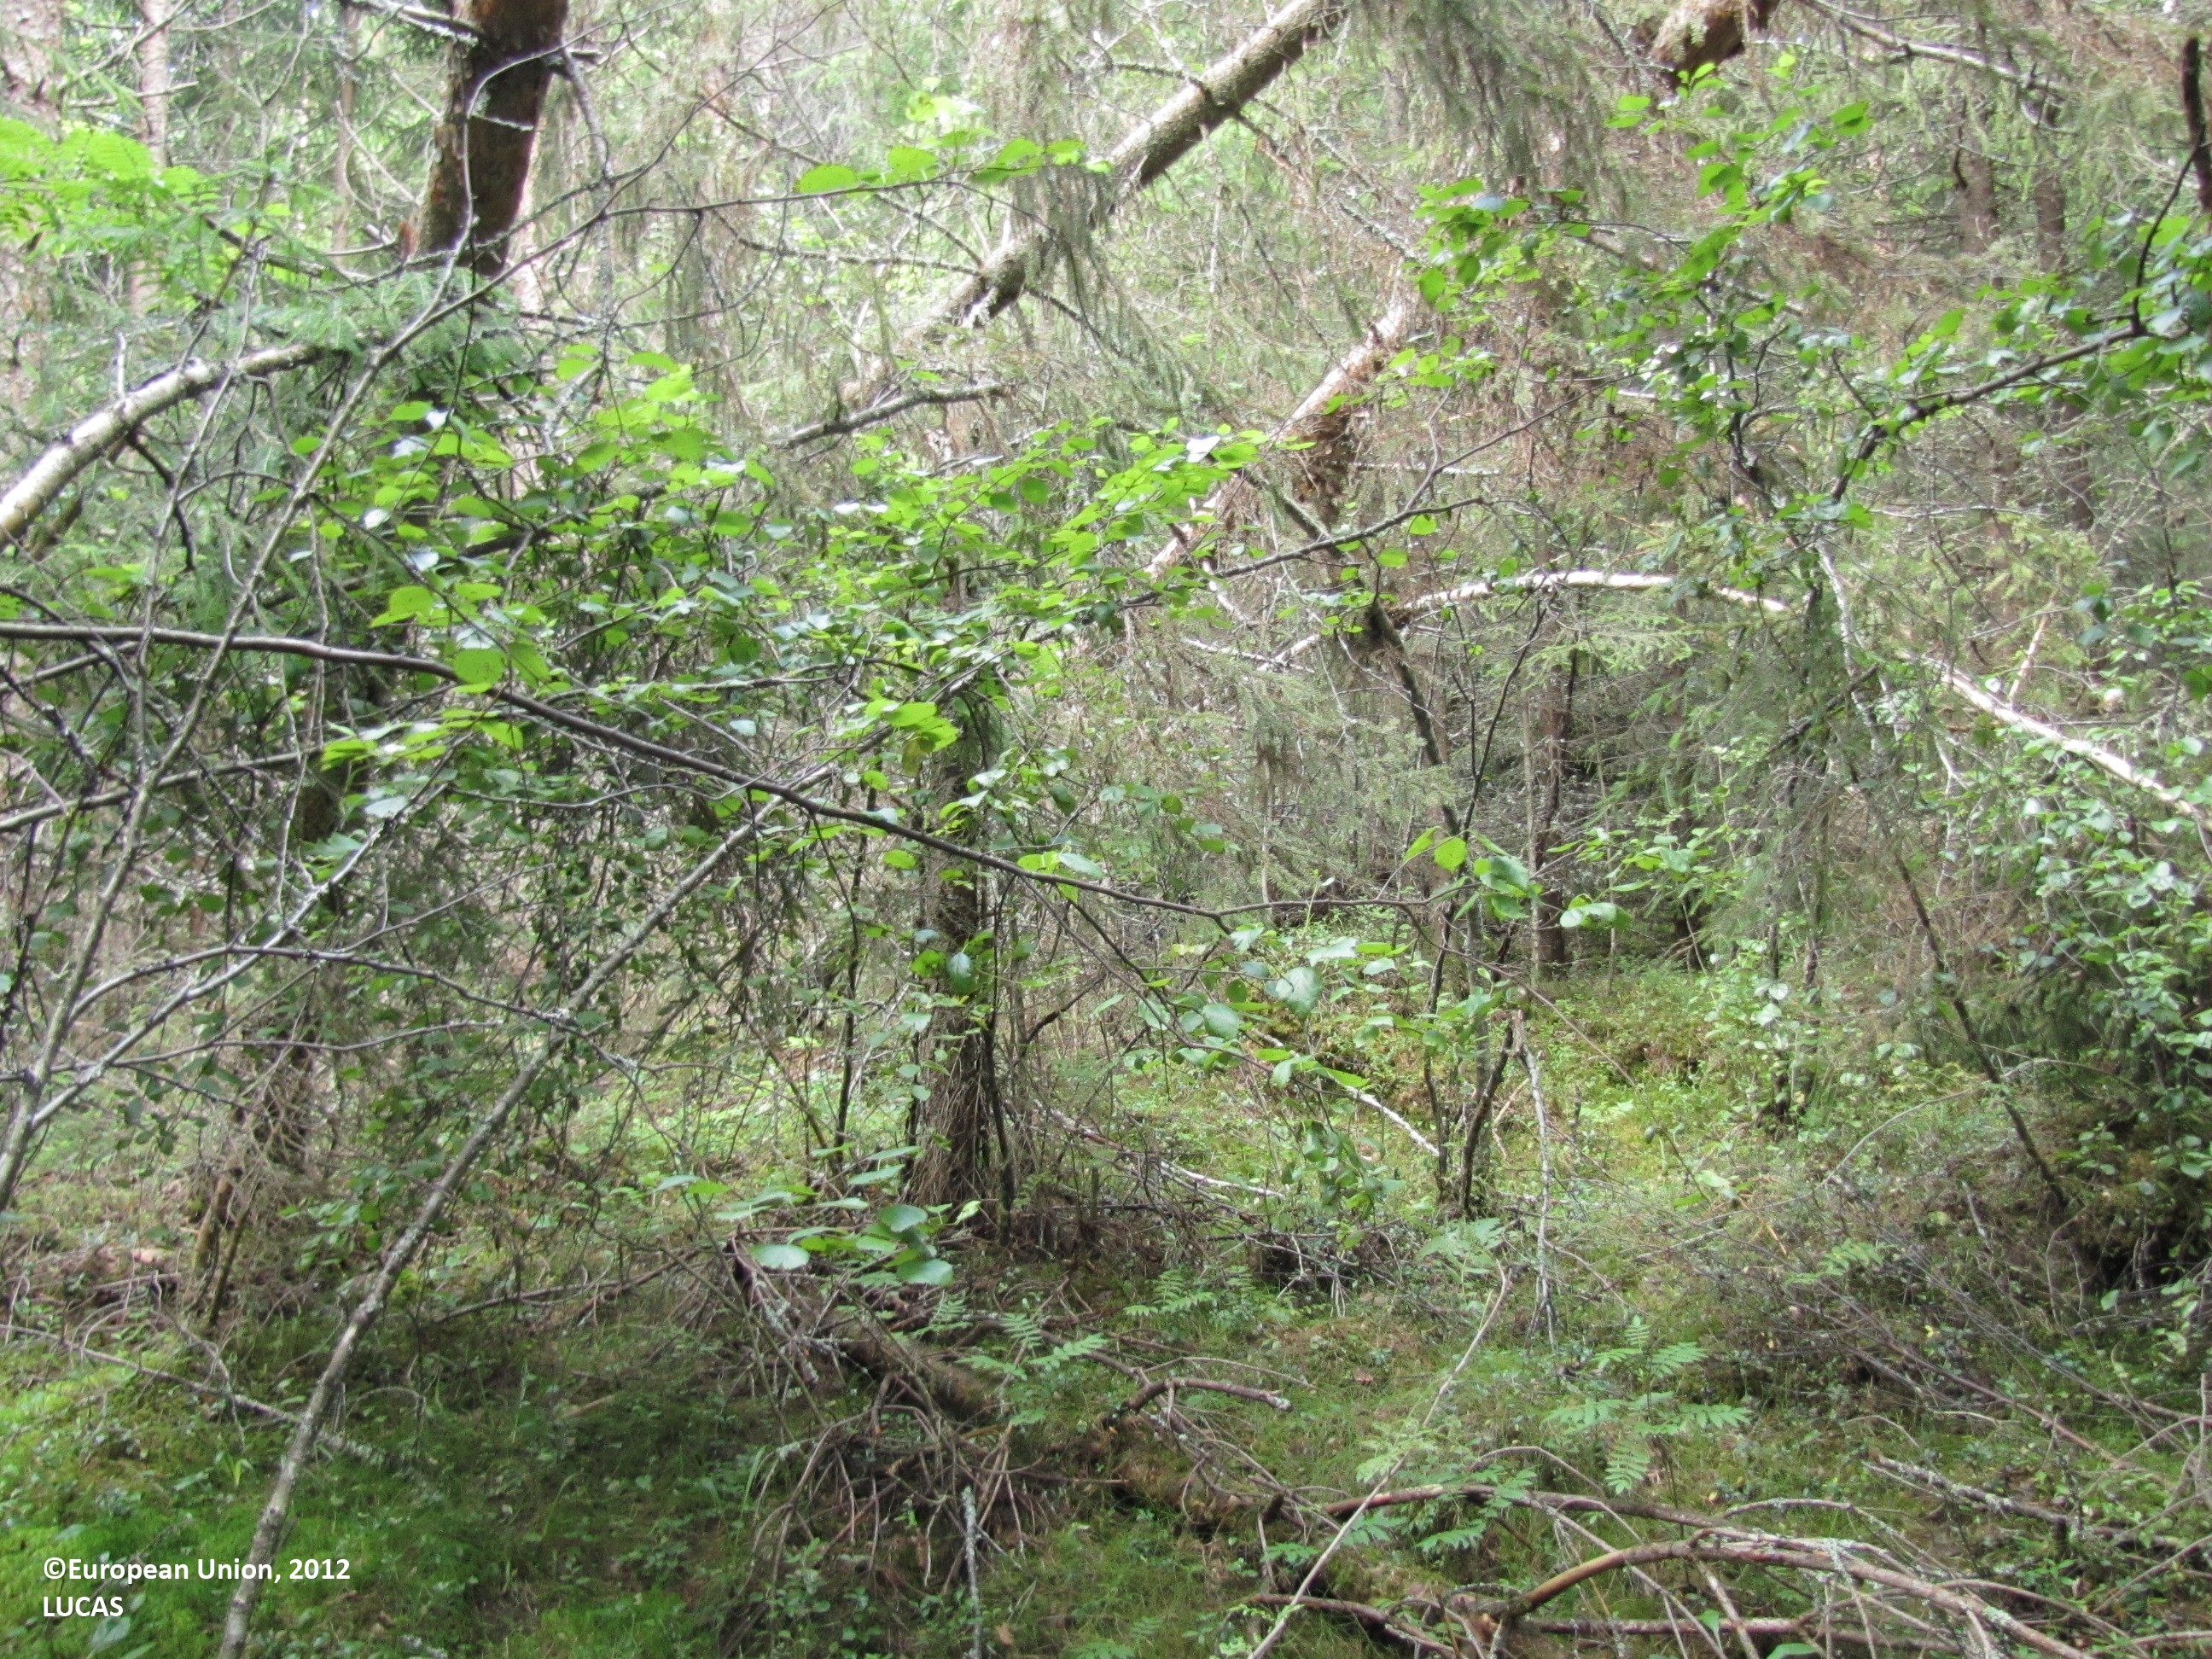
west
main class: Woodland
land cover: Spruce dominated mixed woodland
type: boreal forest
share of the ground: > 75 %
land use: Forestry
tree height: > 5 m
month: July
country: FI
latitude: 62.0919
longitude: 23.3049
